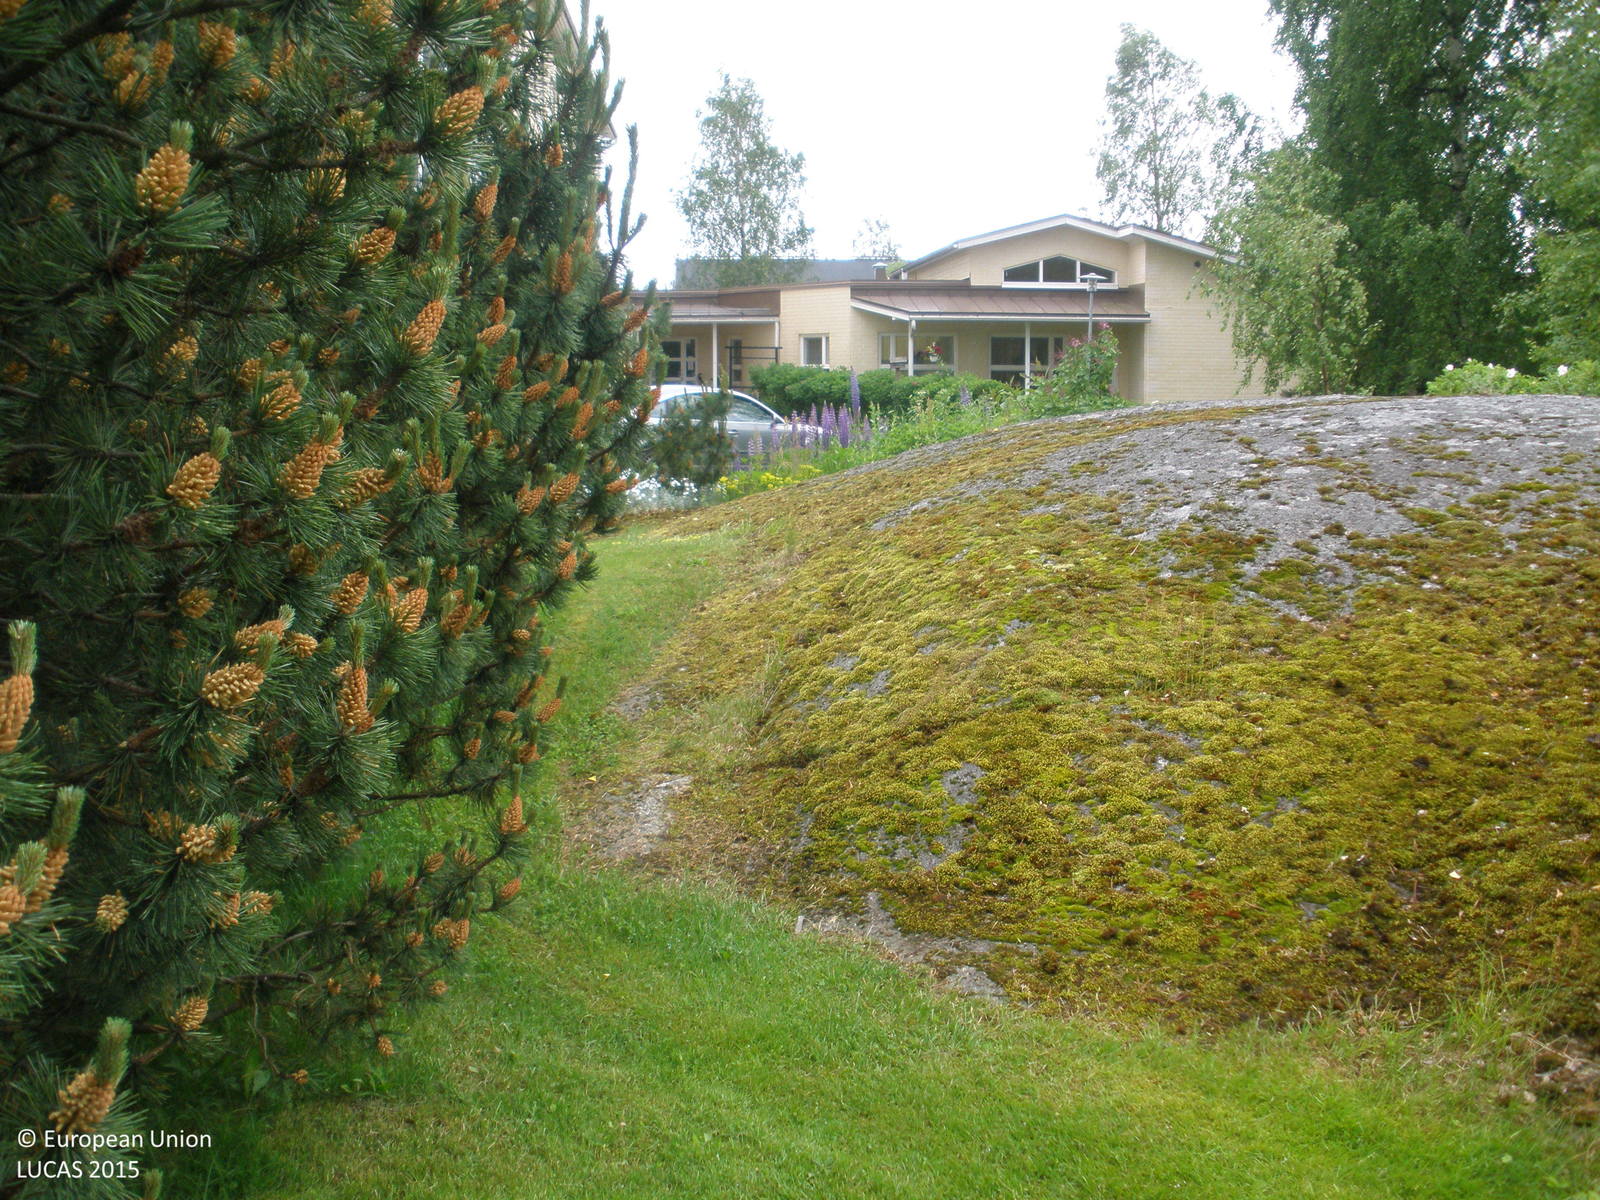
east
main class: Grassland
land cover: Grassland with sparse tree/shrub cover
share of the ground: > 75 %
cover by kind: herbaceous plants 95 %, coniferous forest trees 5 %
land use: Community services
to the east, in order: Grassland with sparse tree/shrub cover; Artificial constructions in urban areas; Grassland without tree/shrub cover; Artificial constructions in urban areas
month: June
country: FI
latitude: 61.0785
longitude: 23.5597
